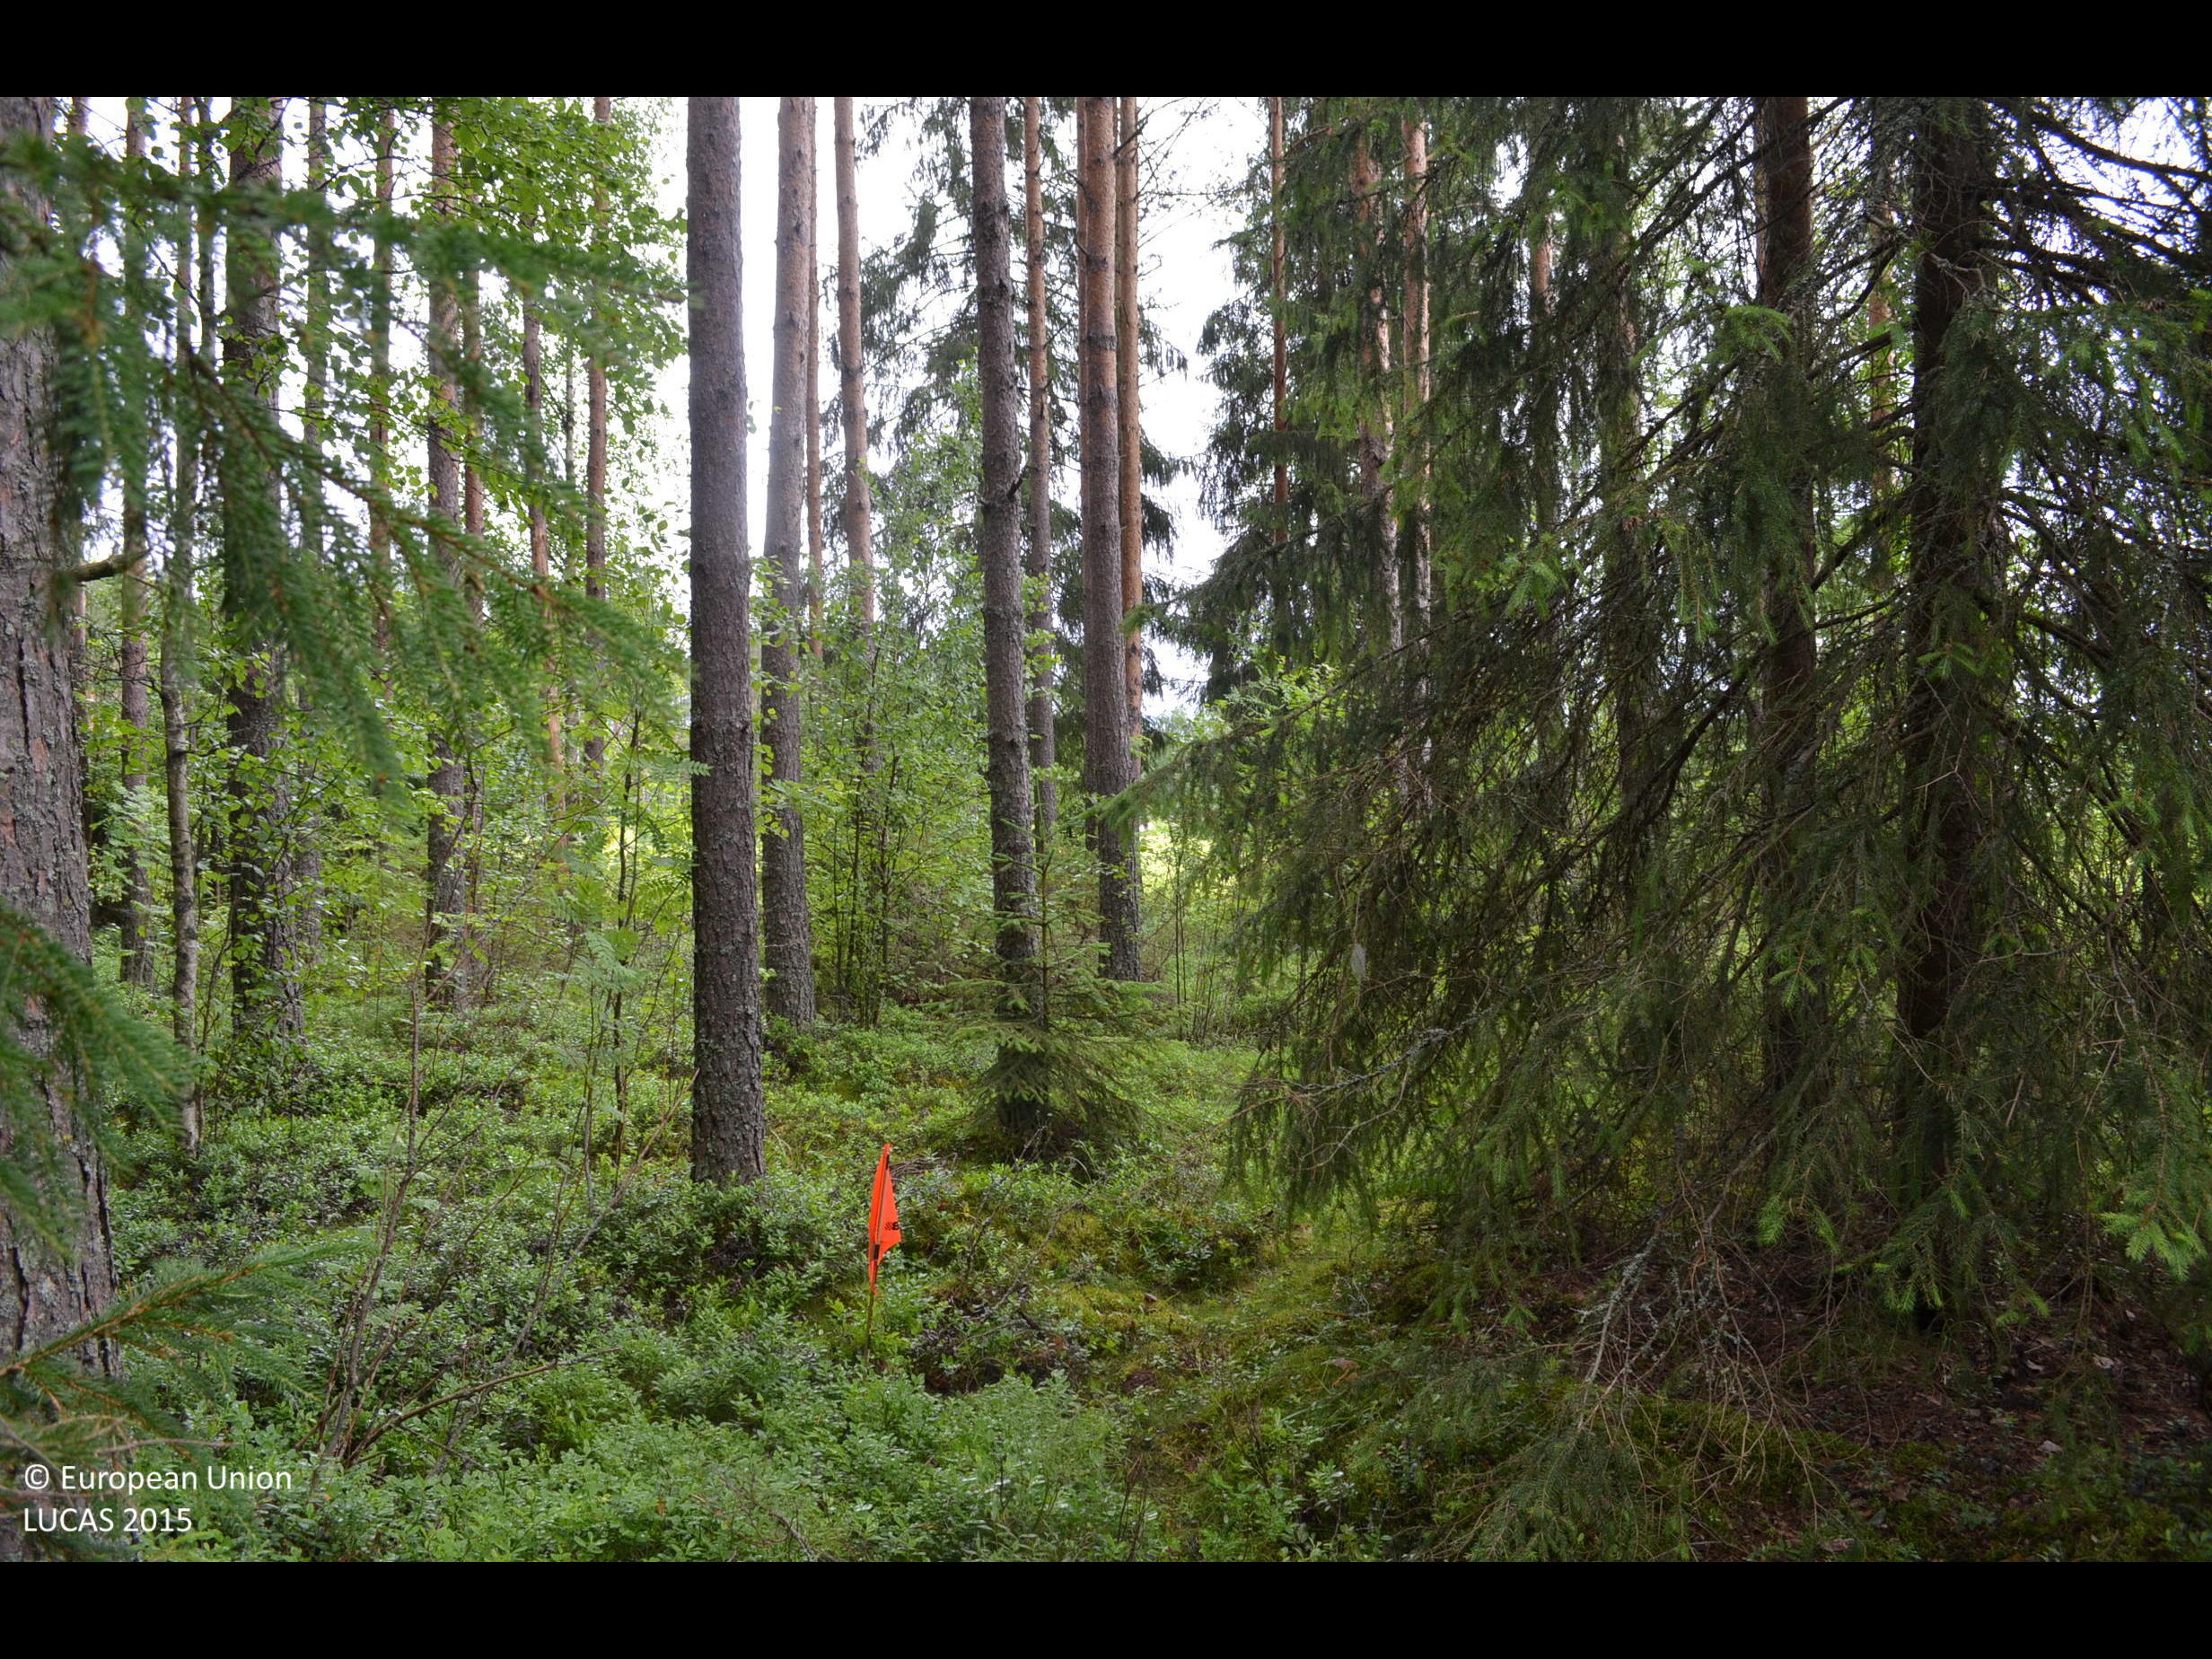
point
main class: Woodland
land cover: Pine dominated coniferous woodland
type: boreal forest
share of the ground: > 75 %
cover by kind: coniferous forest trees 80 %, broadleaved forest trees 10 %, shrubs 10 %
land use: Forestry
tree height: > 5 m
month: July
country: FI
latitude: 62.2863
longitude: 23.5861
